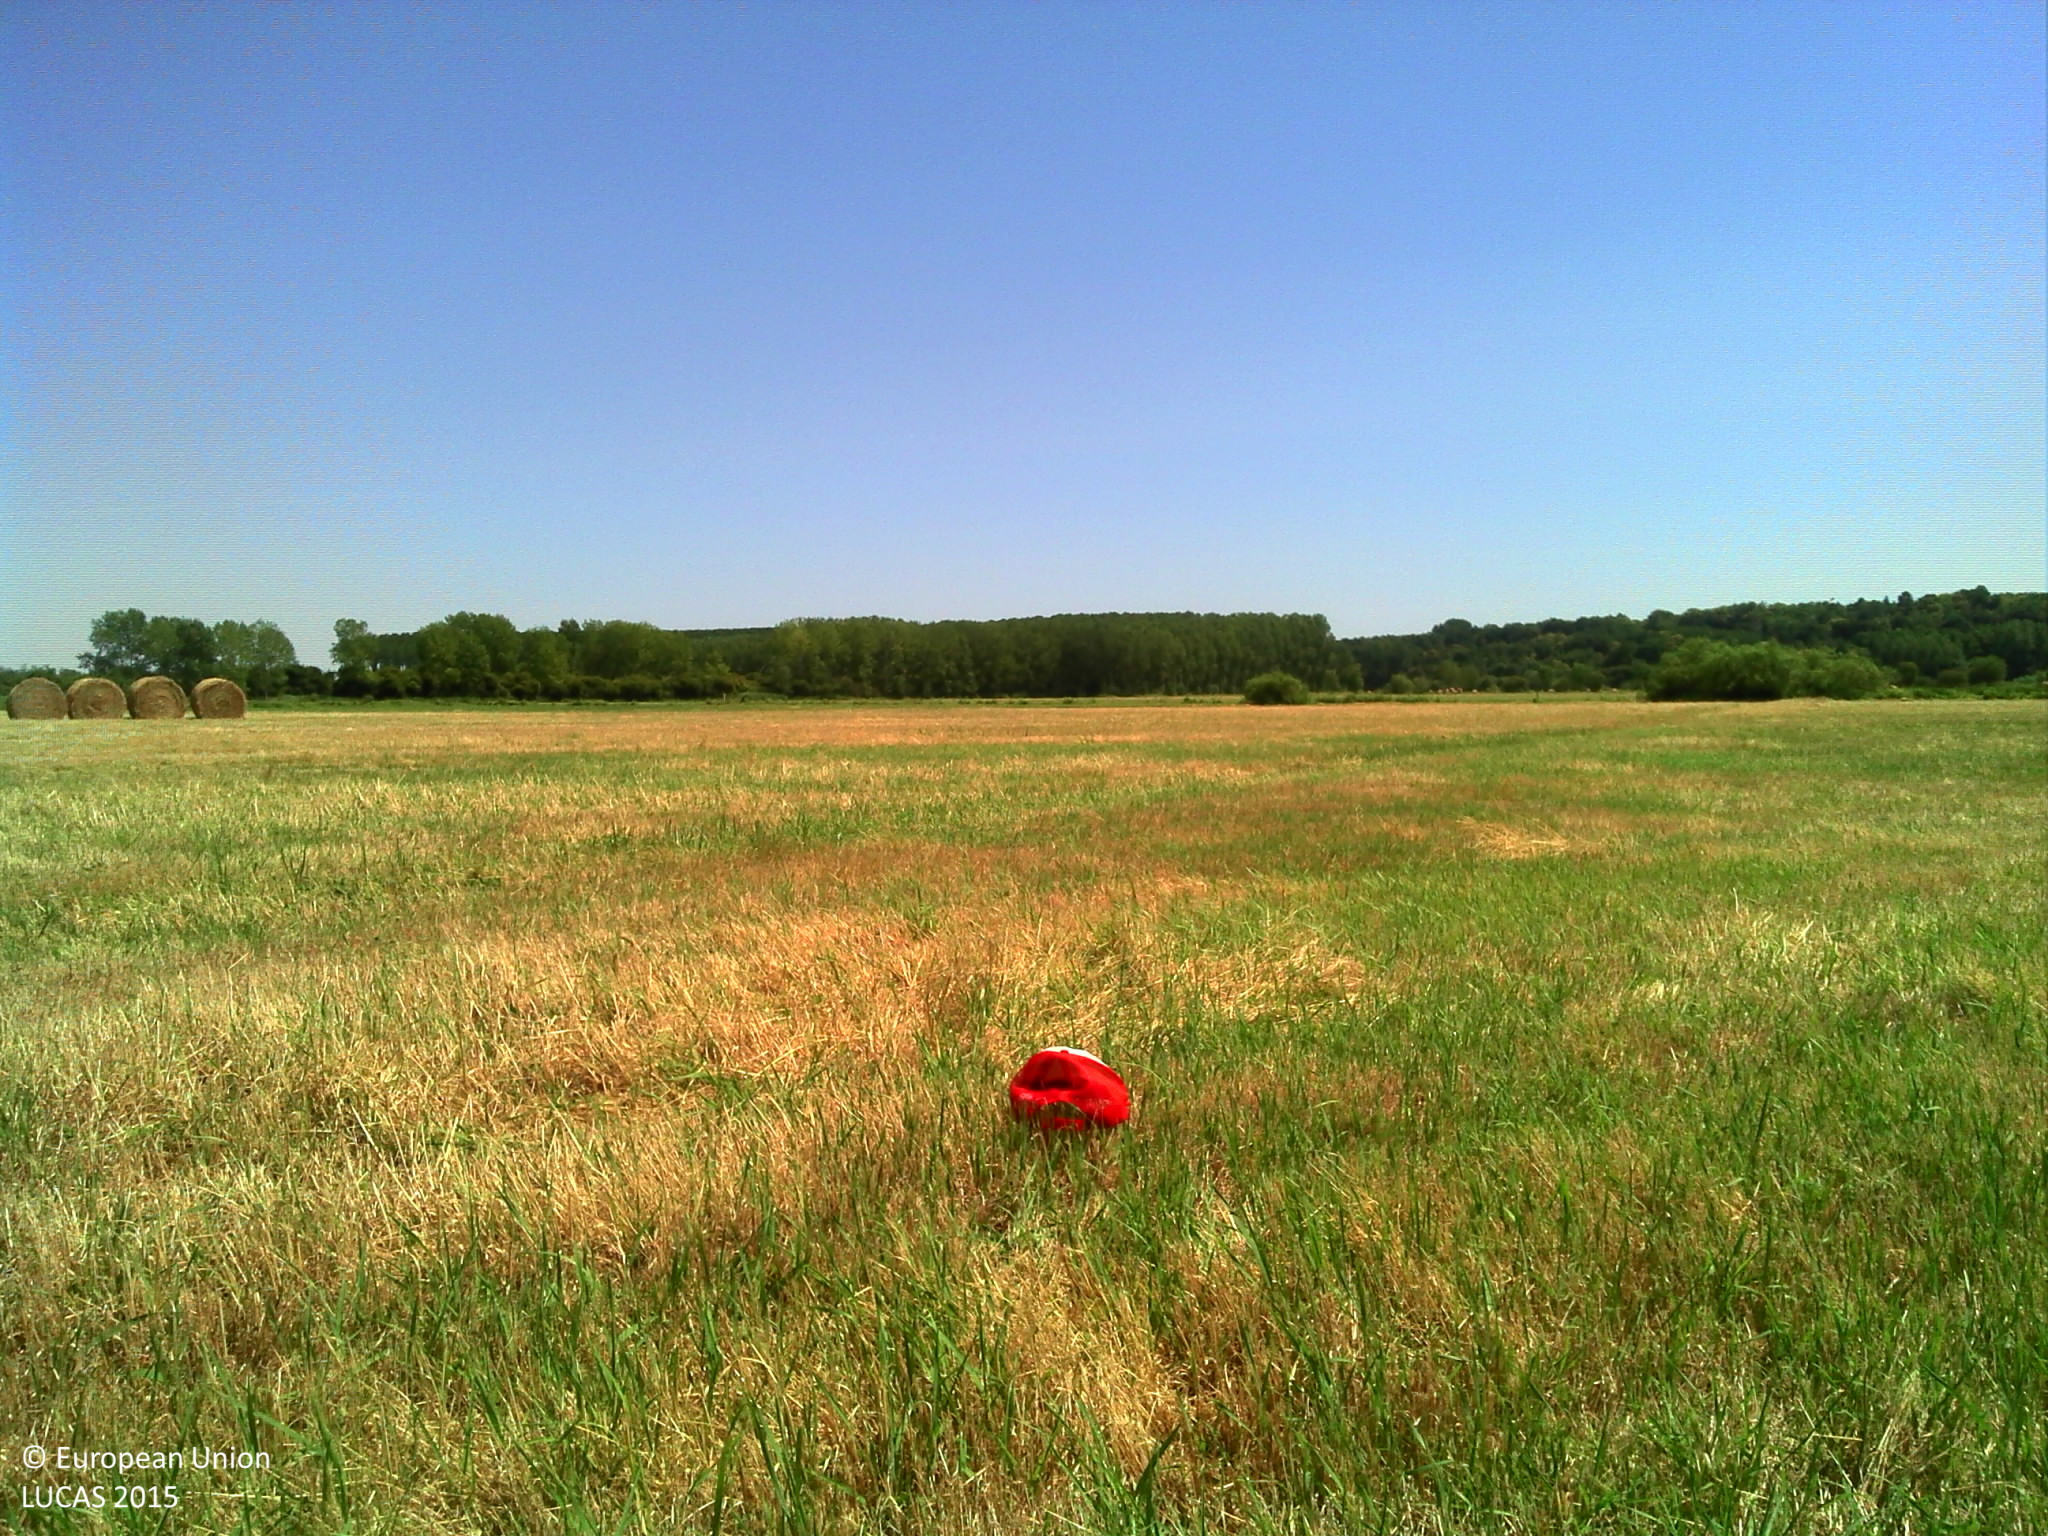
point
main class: Grassland
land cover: Grassland without tree/shrub cover
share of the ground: > 75 %
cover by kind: herbaceous plants 100 %
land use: Agriculture (excluding fallow land and kitchen gardens)
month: July
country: FR
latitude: 47.6718
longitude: -2.0242
